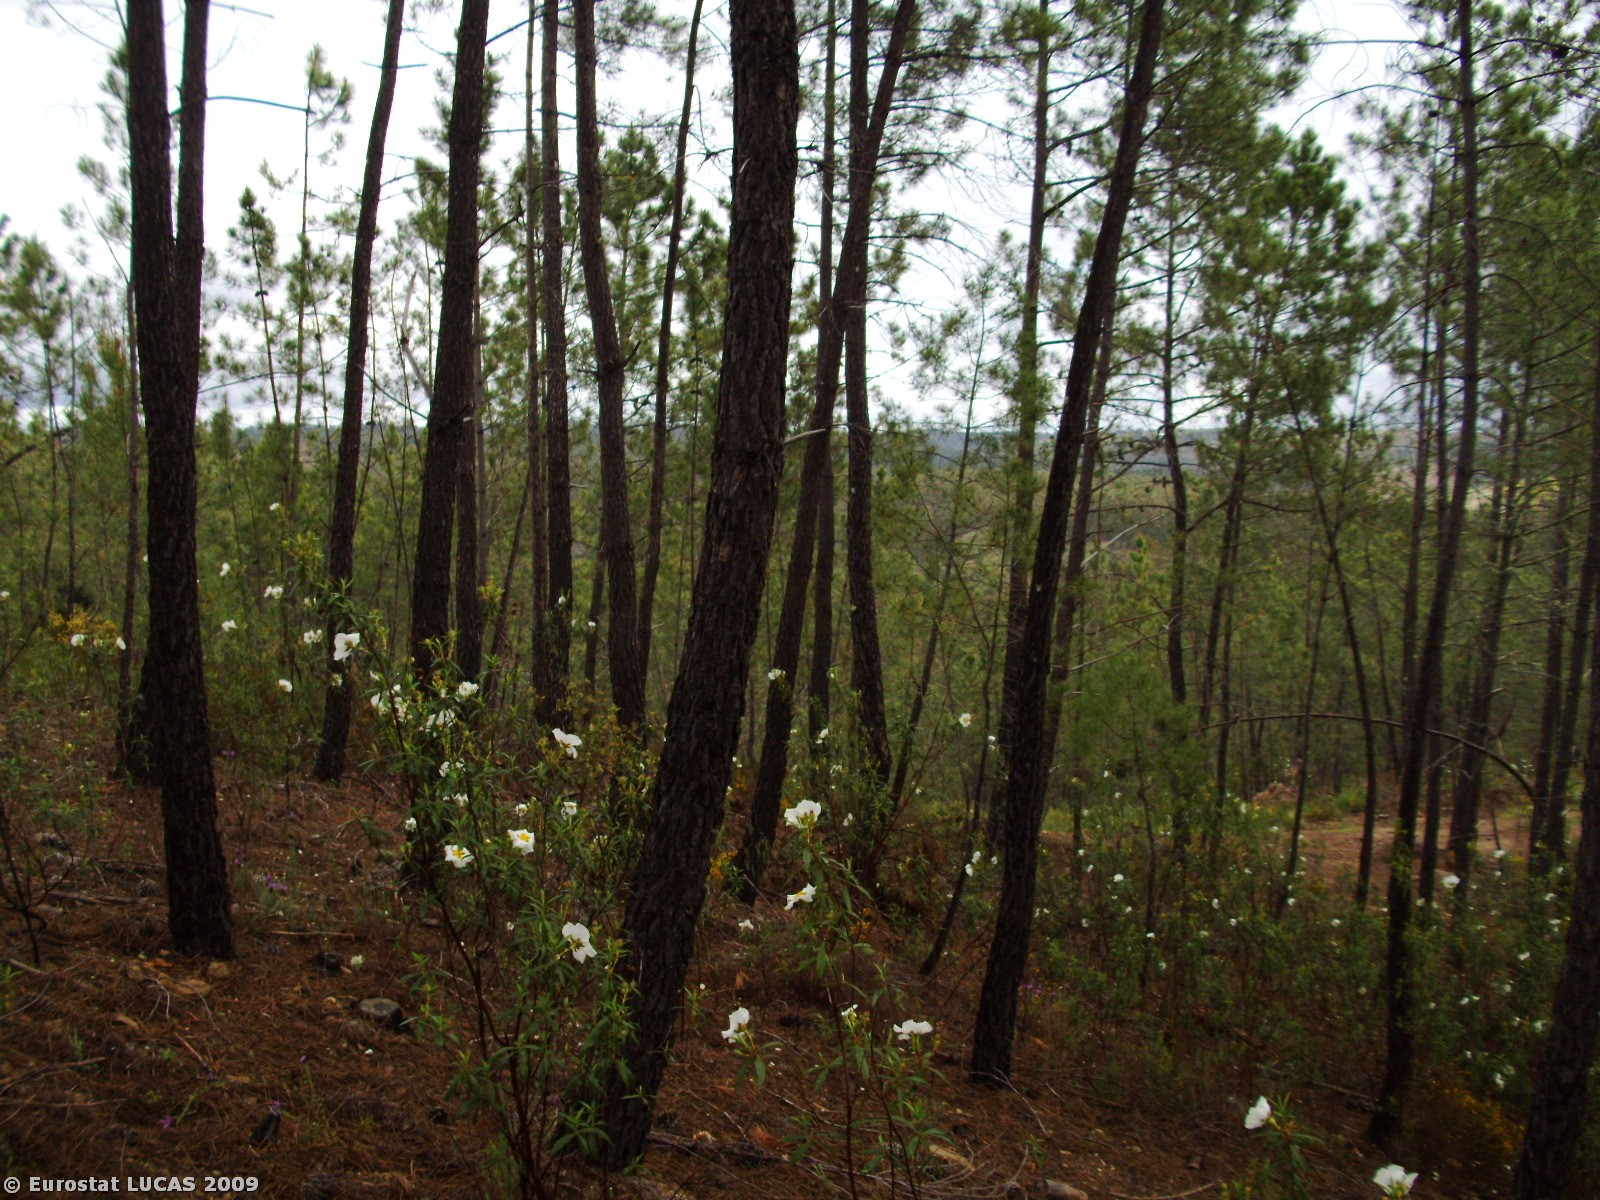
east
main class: Woodland
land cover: Coniferous woodland
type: coniferous forest of the mediterranean region
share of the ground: 50 - 75 %
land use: Forestry
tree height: > 5 m
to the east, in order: Coniferous woodland; Olive groves
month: April
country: PT
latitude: 39.8443
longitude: -7.5971
